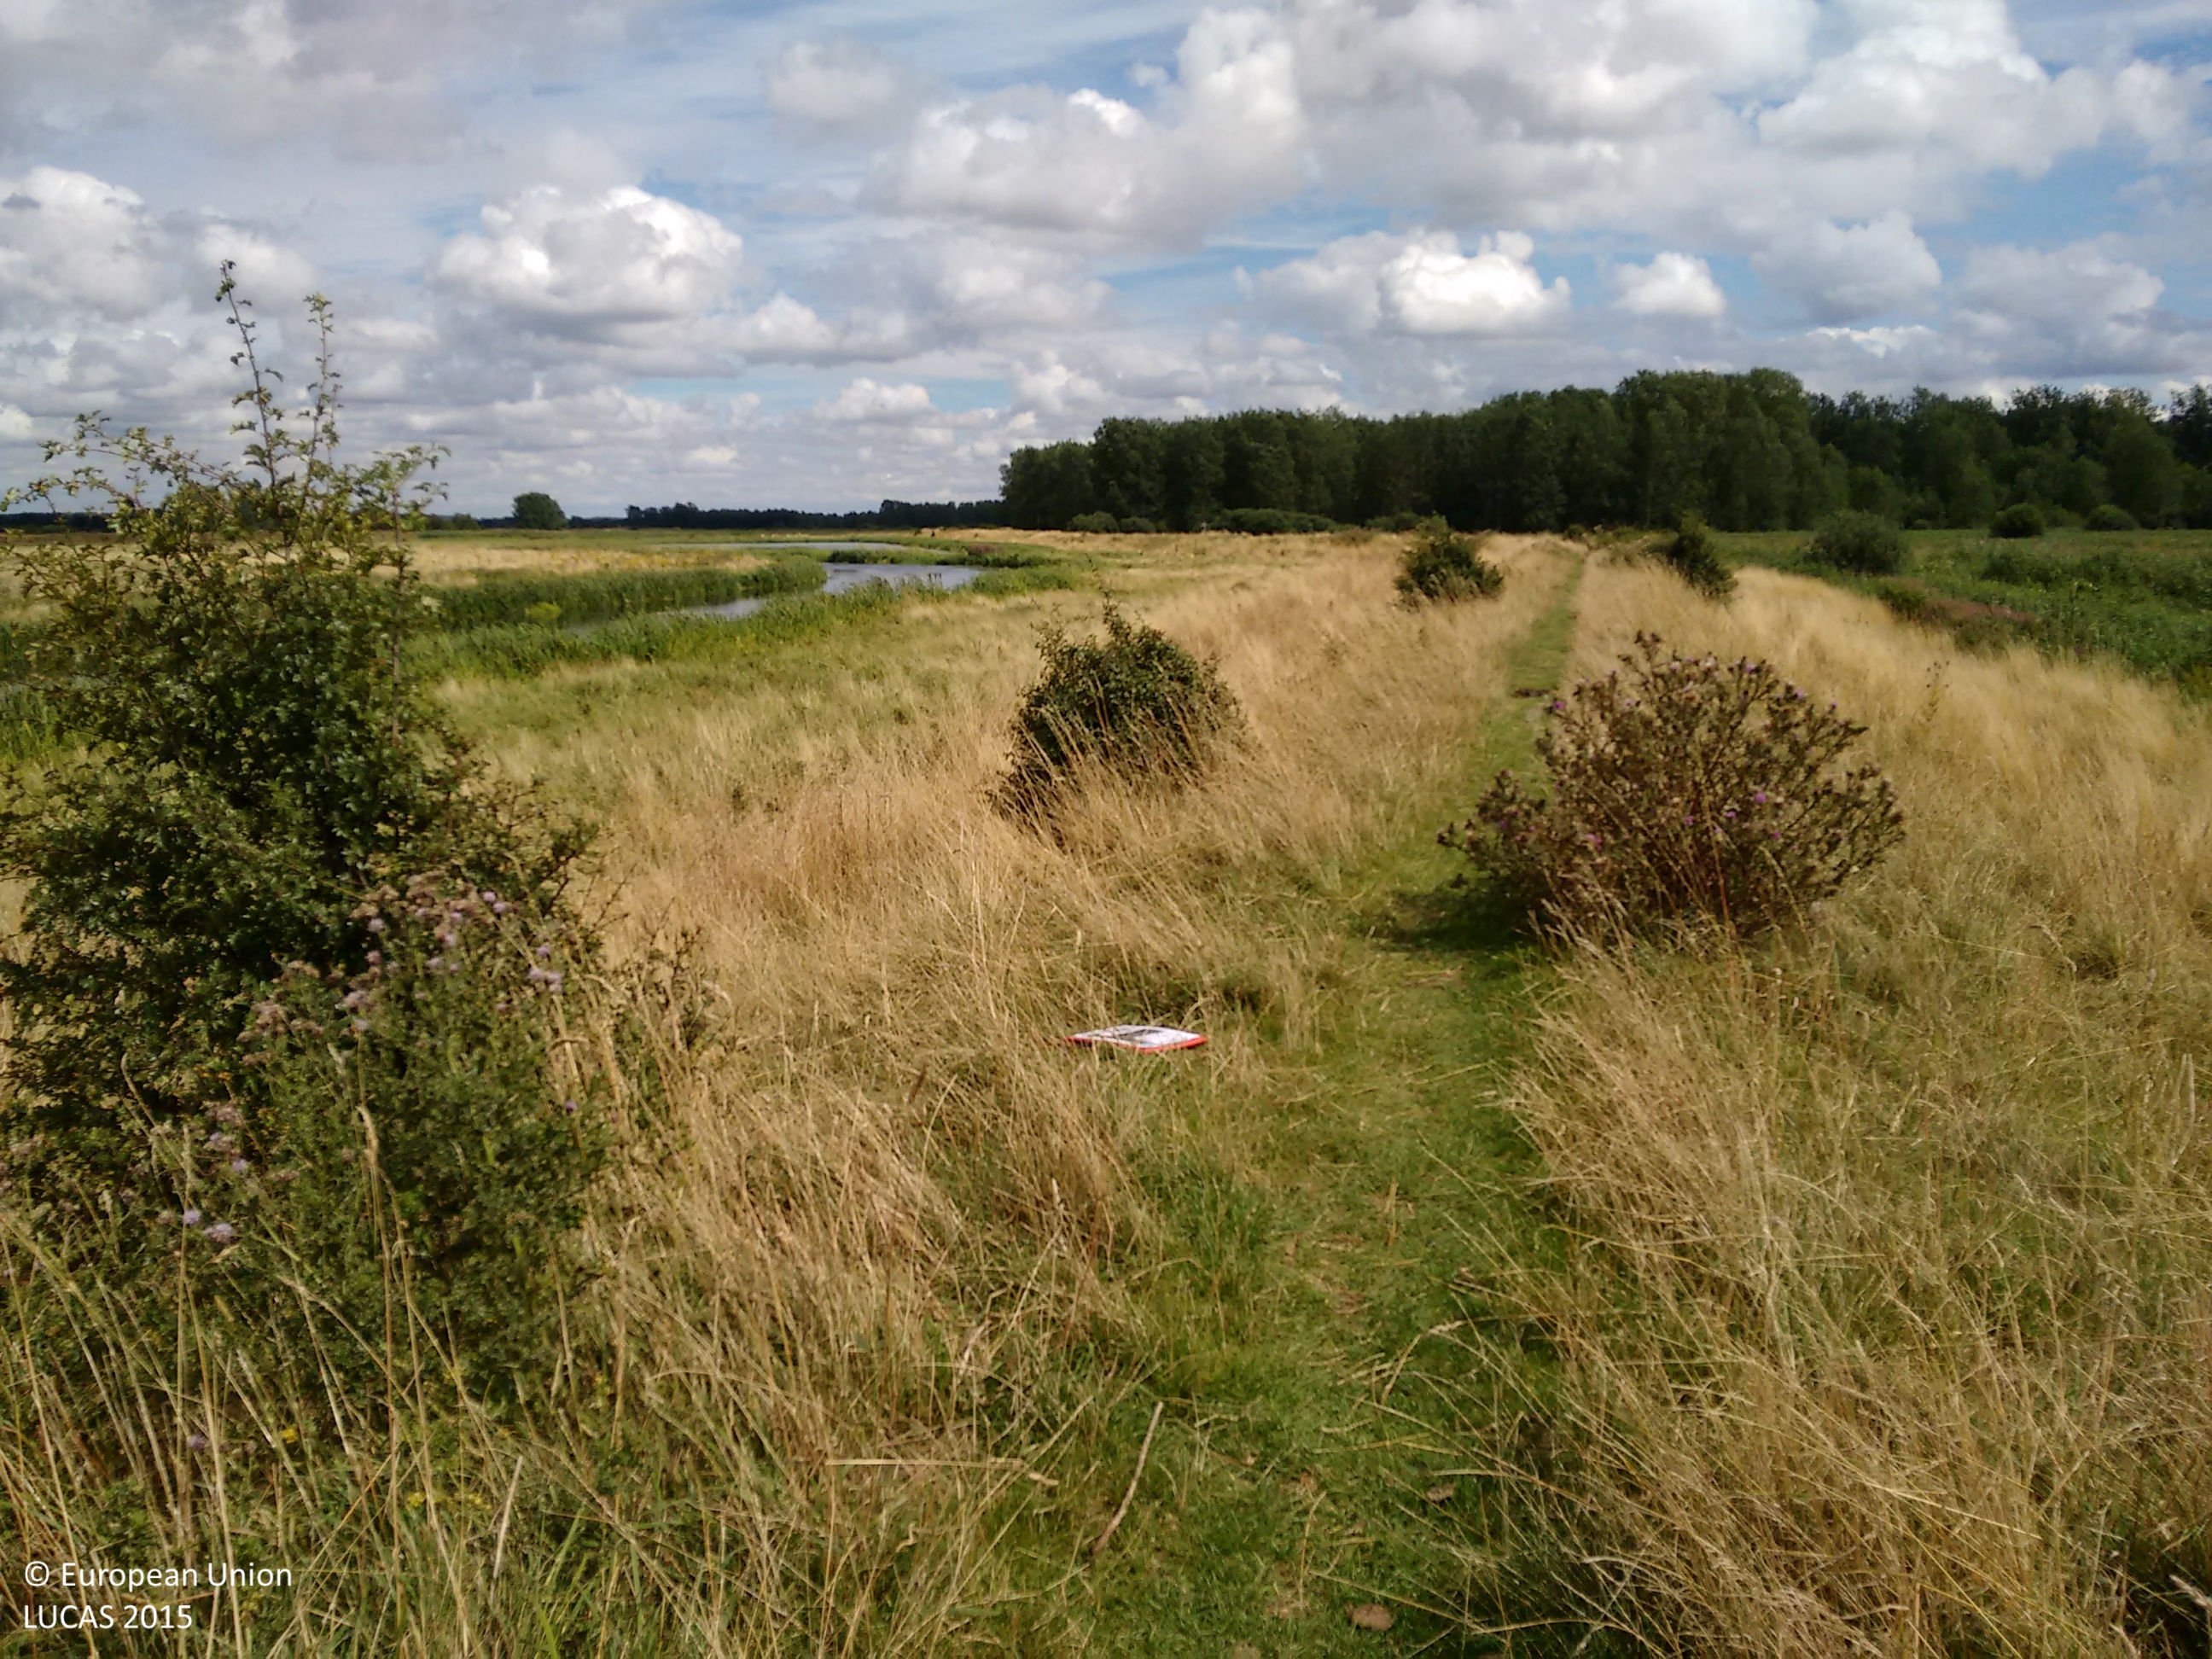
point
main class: Grassland
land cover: Grassland with sparse tree/shrub cover
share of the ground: > 75 %
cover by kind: herbaceous plants 95 %, broadleaved forest trees 5 %
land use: Agriculture (excluding fallow land and kitchen gardens)
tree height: < 5 m
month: August
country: GB
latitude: 52.4493
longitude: 0.5116
